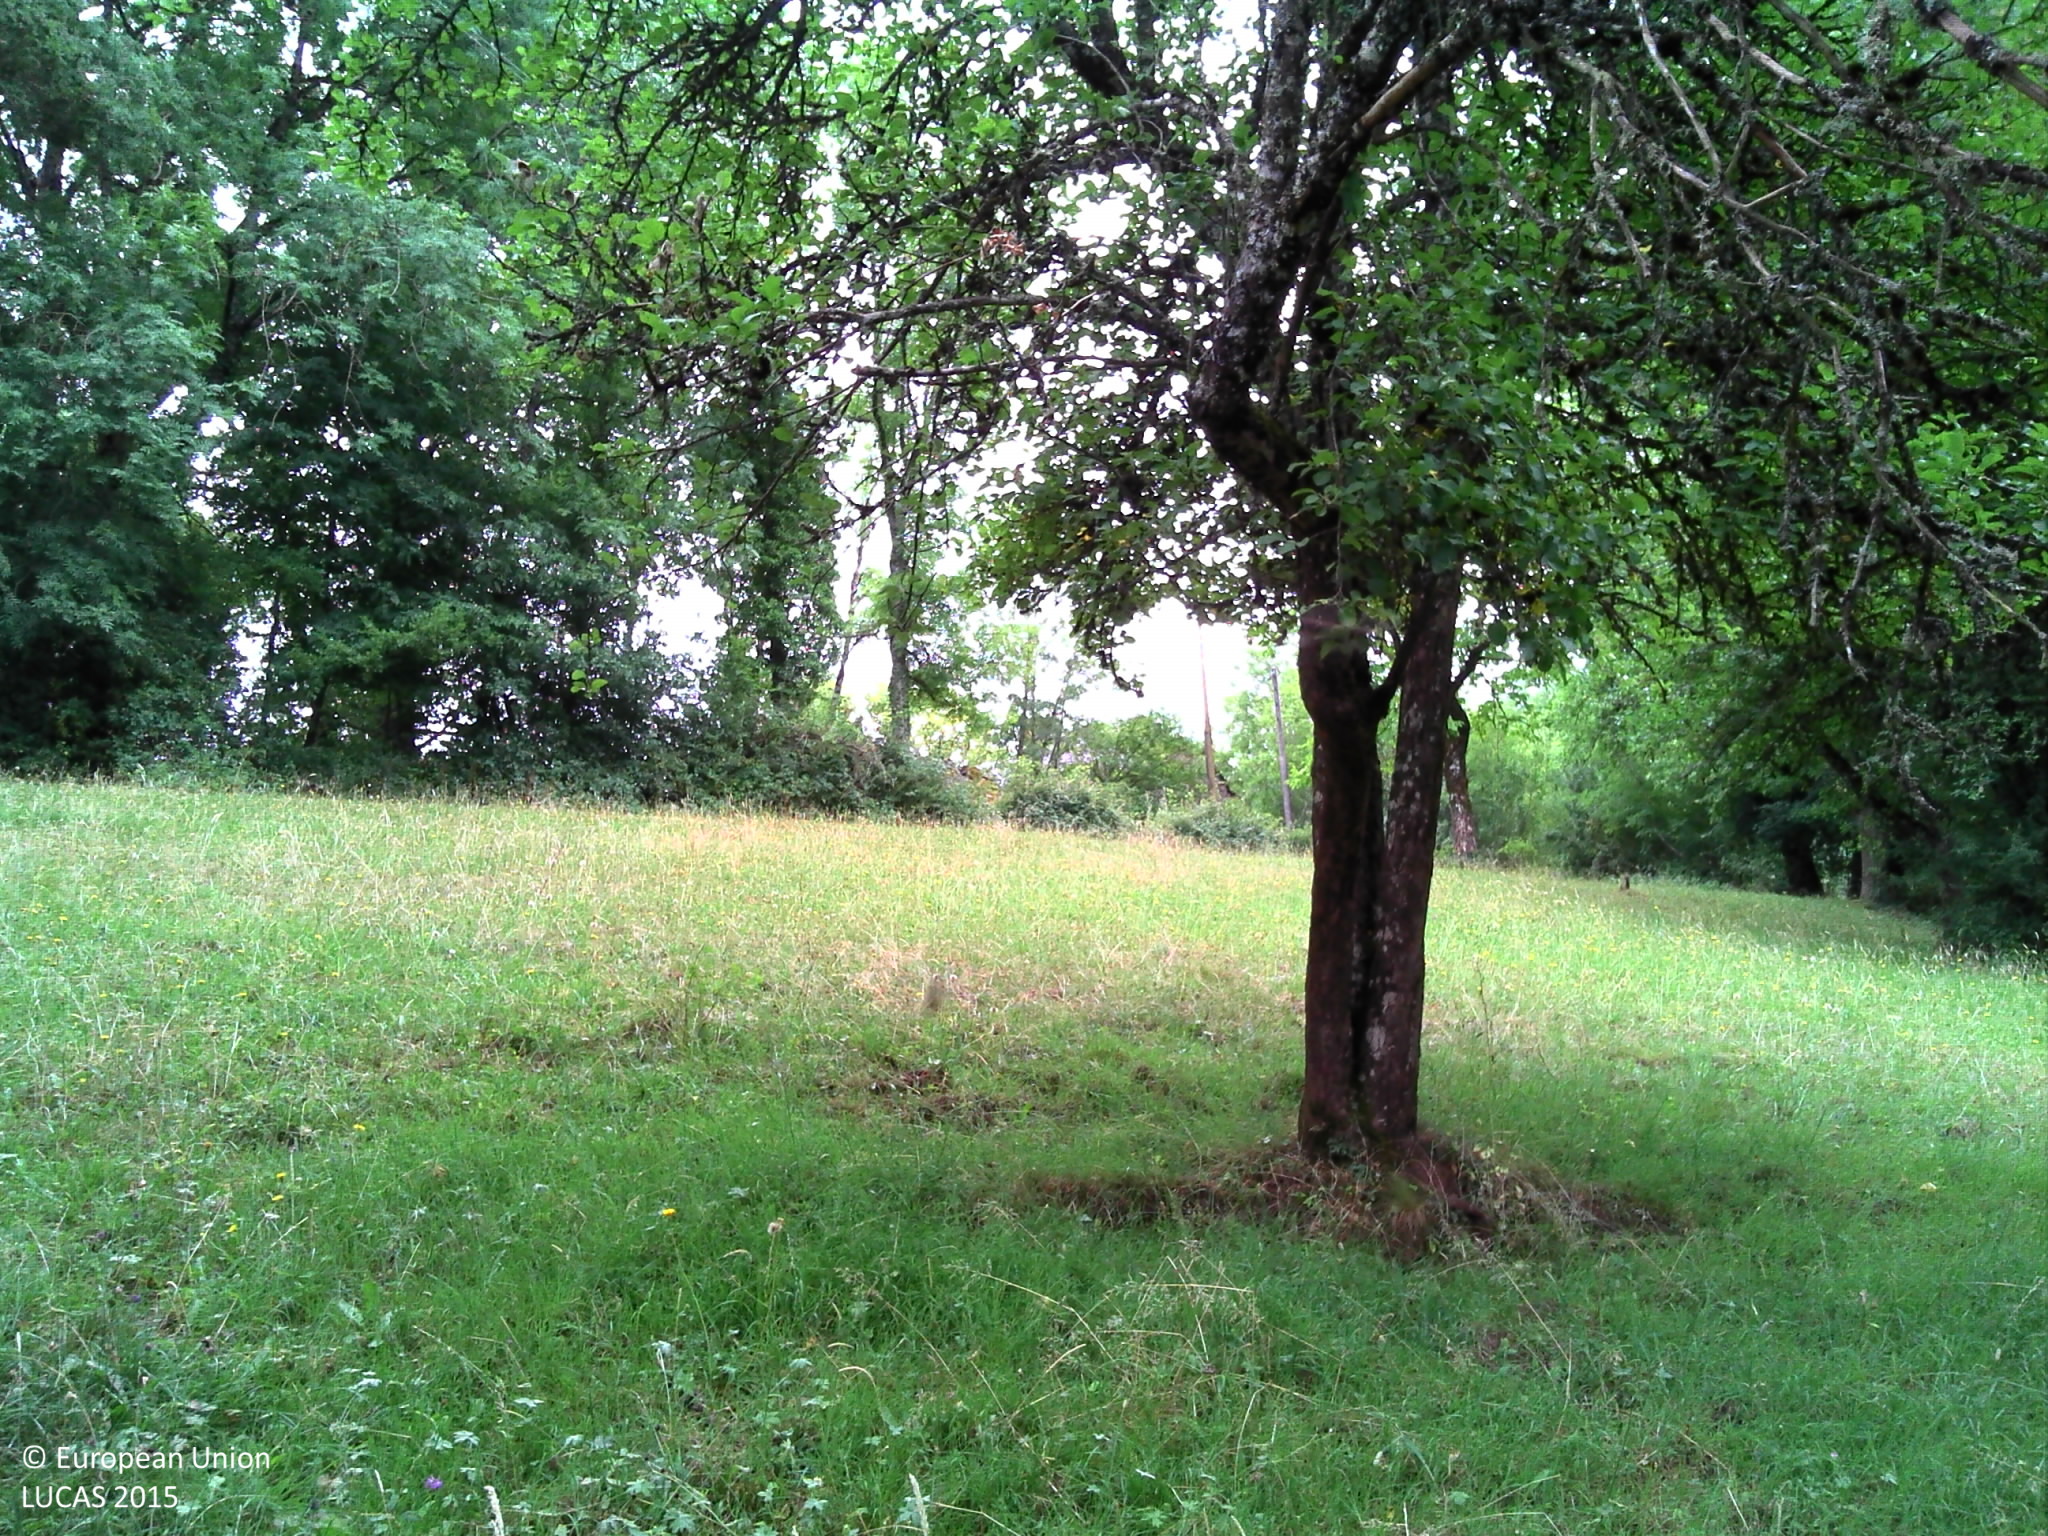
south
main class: Woodland
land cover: Broadleaved woodland
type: mesophytic deciduous forest
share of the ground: > 75 %
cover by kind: broadleaved forest trees 85 %, shrubs 10 %, lichens and mosses 5 %
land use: Forestry
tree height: > 5 m
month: July
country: FR
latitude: 44.4436
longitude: 3.0561
